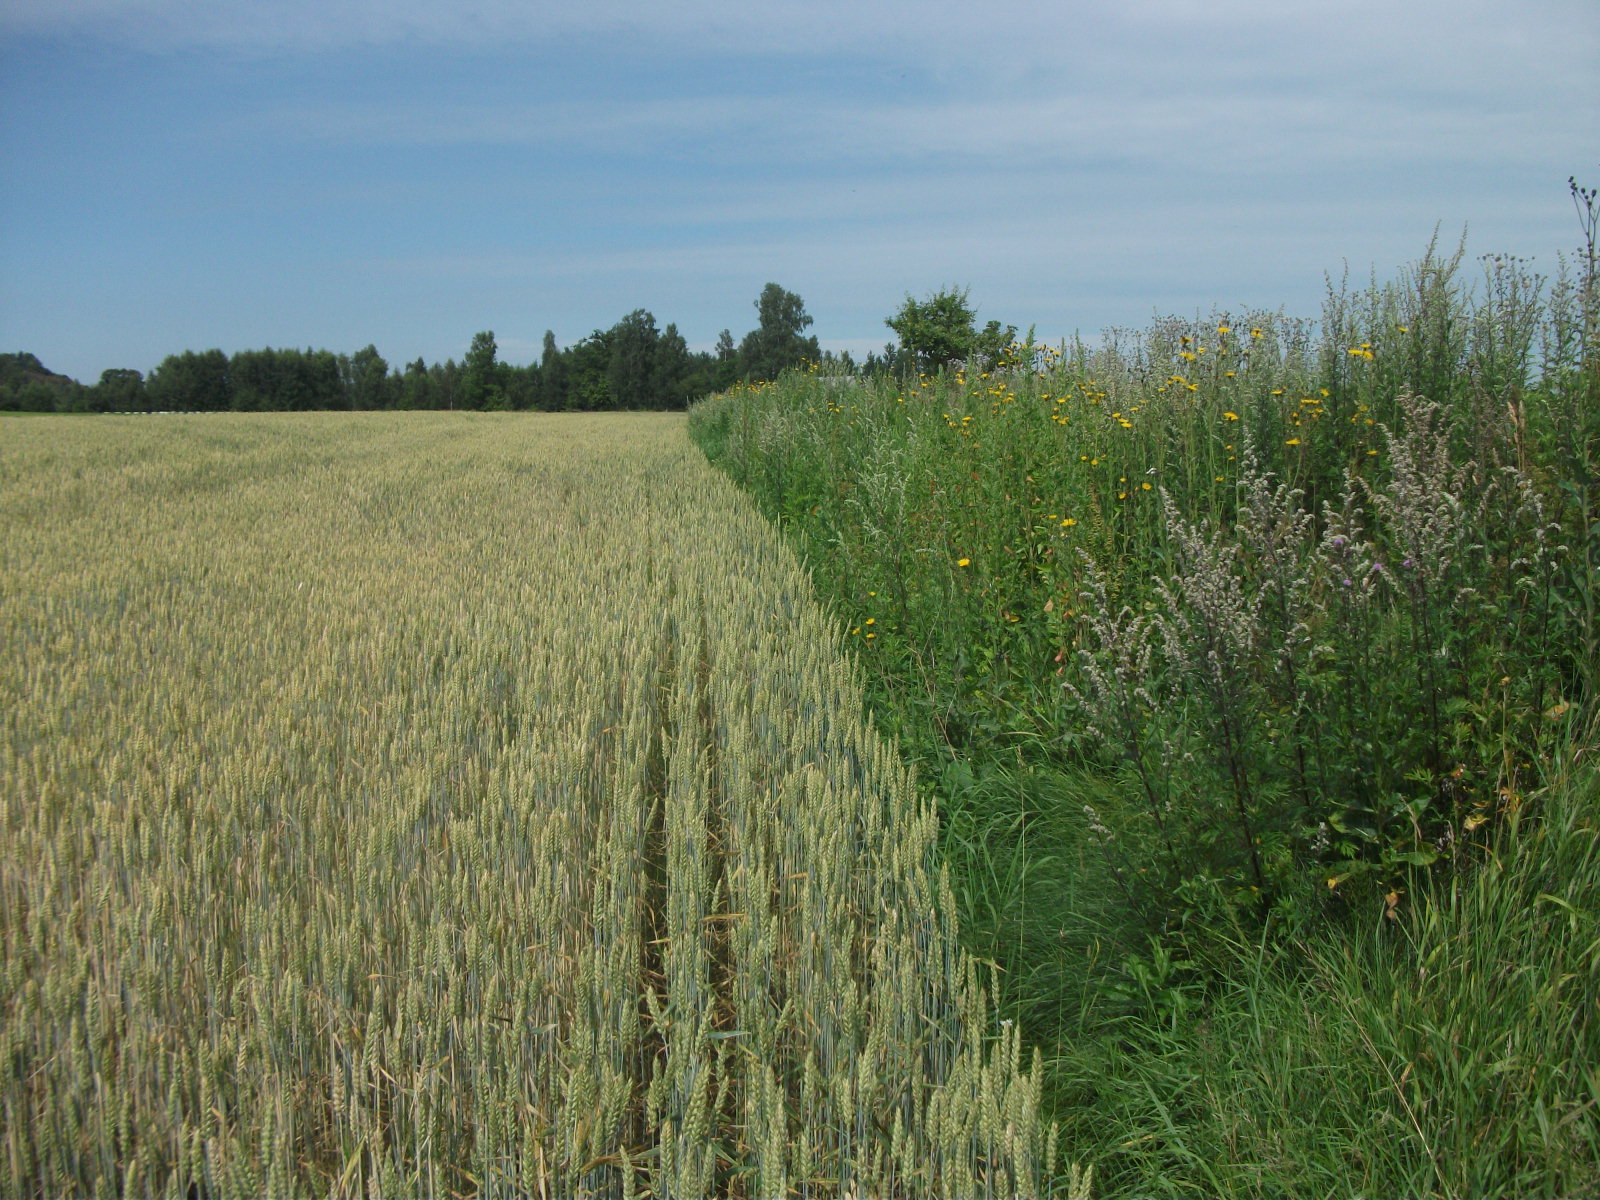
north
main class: Cropland
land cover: Common wheat
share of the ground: > 75 %
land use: Agriculture (excluding fallow land and kitchen gardens)
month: August
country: LV
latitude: 57.1236
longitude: 26.7183
